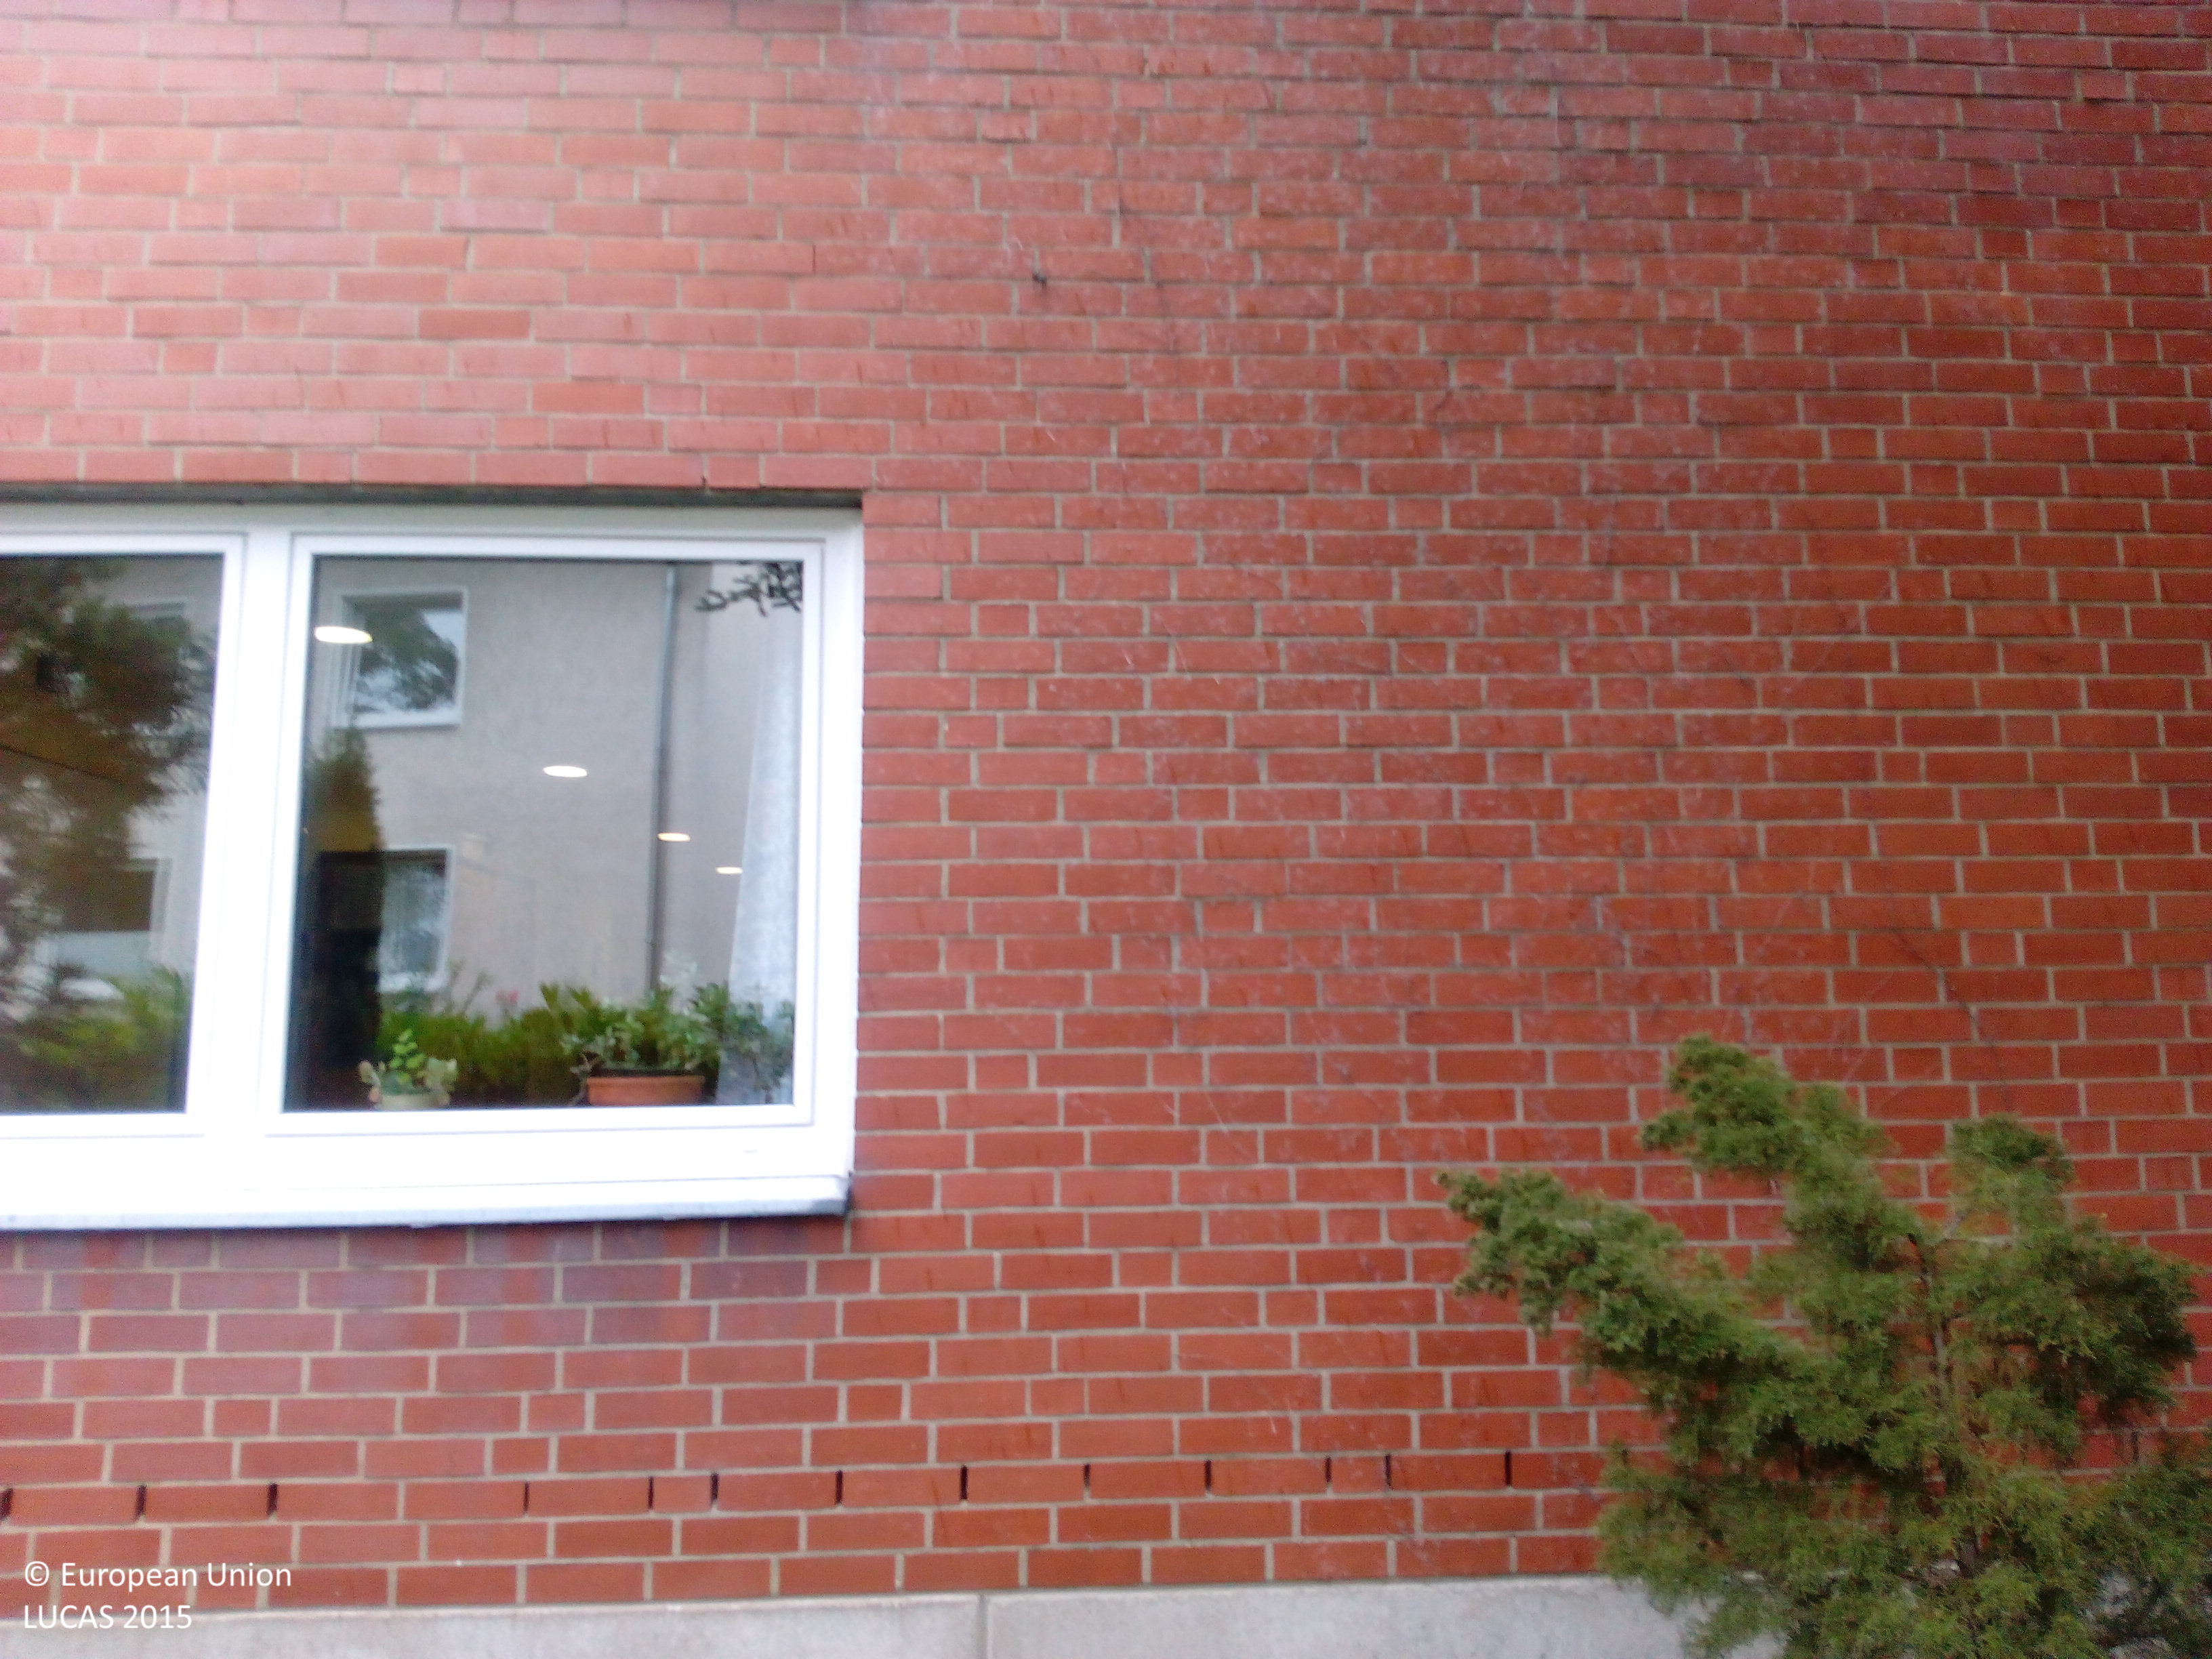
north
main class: Cropland
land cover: Floriculture and ornamental plants
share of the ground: 50 - 75 %
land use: Residential
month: July
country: DE
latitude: 52.2711
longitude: 8.0221
